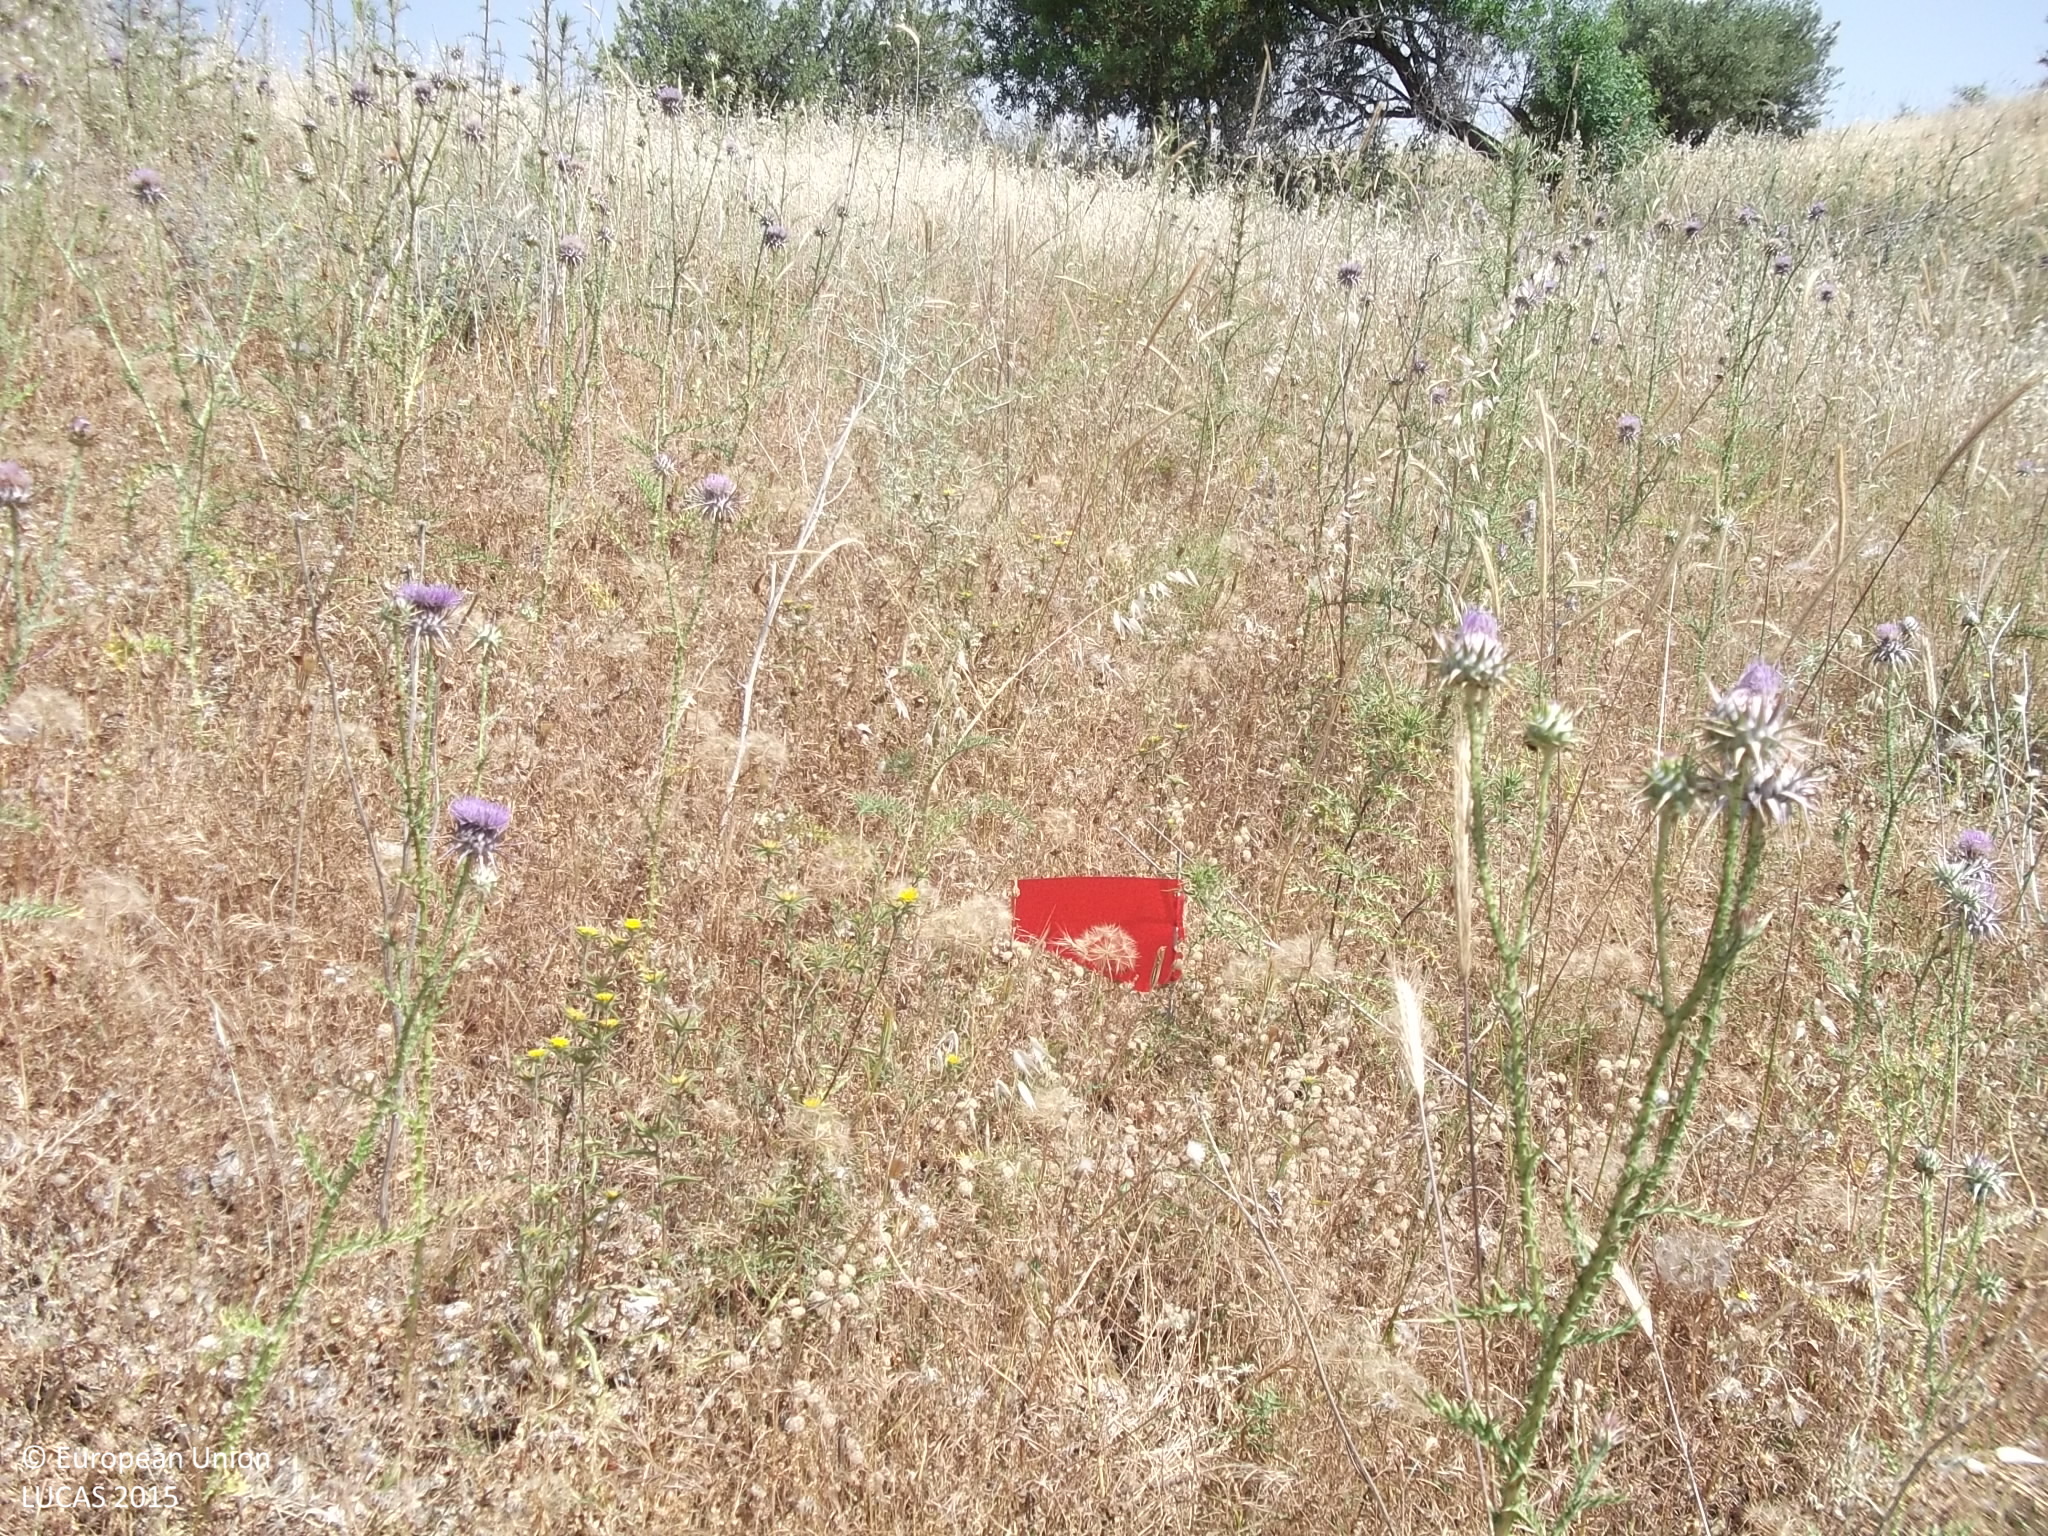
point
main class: Grassland
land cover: Grassland with sparse tree/shrub cover
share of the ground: > 75 %
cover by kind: herbaceous plants 95 %, broadleaved forest trees 5 %
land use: Semi-natural and natural areas not in use
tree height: < 5 m
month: May
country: CY
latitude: 34.8141
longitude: 32.5505
